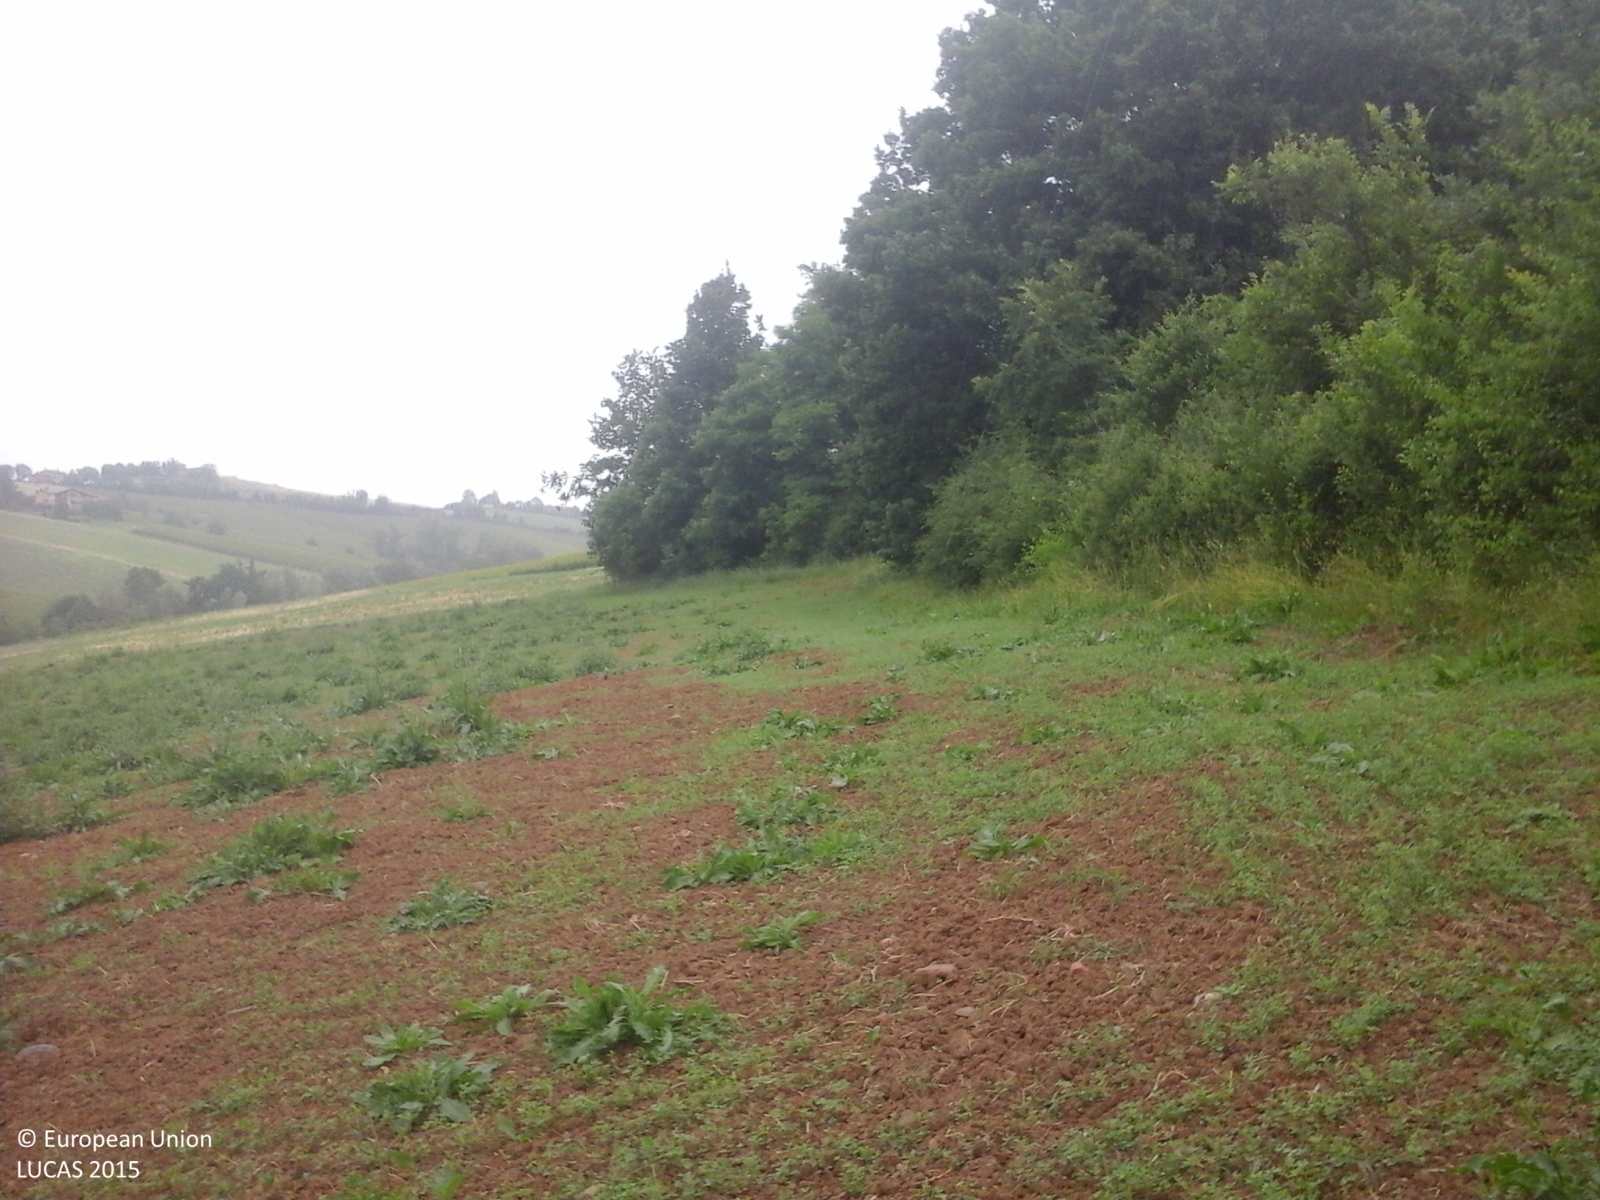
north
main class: Cropland
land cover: Lucerne
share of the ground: < 10 %
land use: Agriculture (excluding fallow land and kitchen gardens)
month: May
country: IT
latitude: 44.5084
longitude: 10.9664
